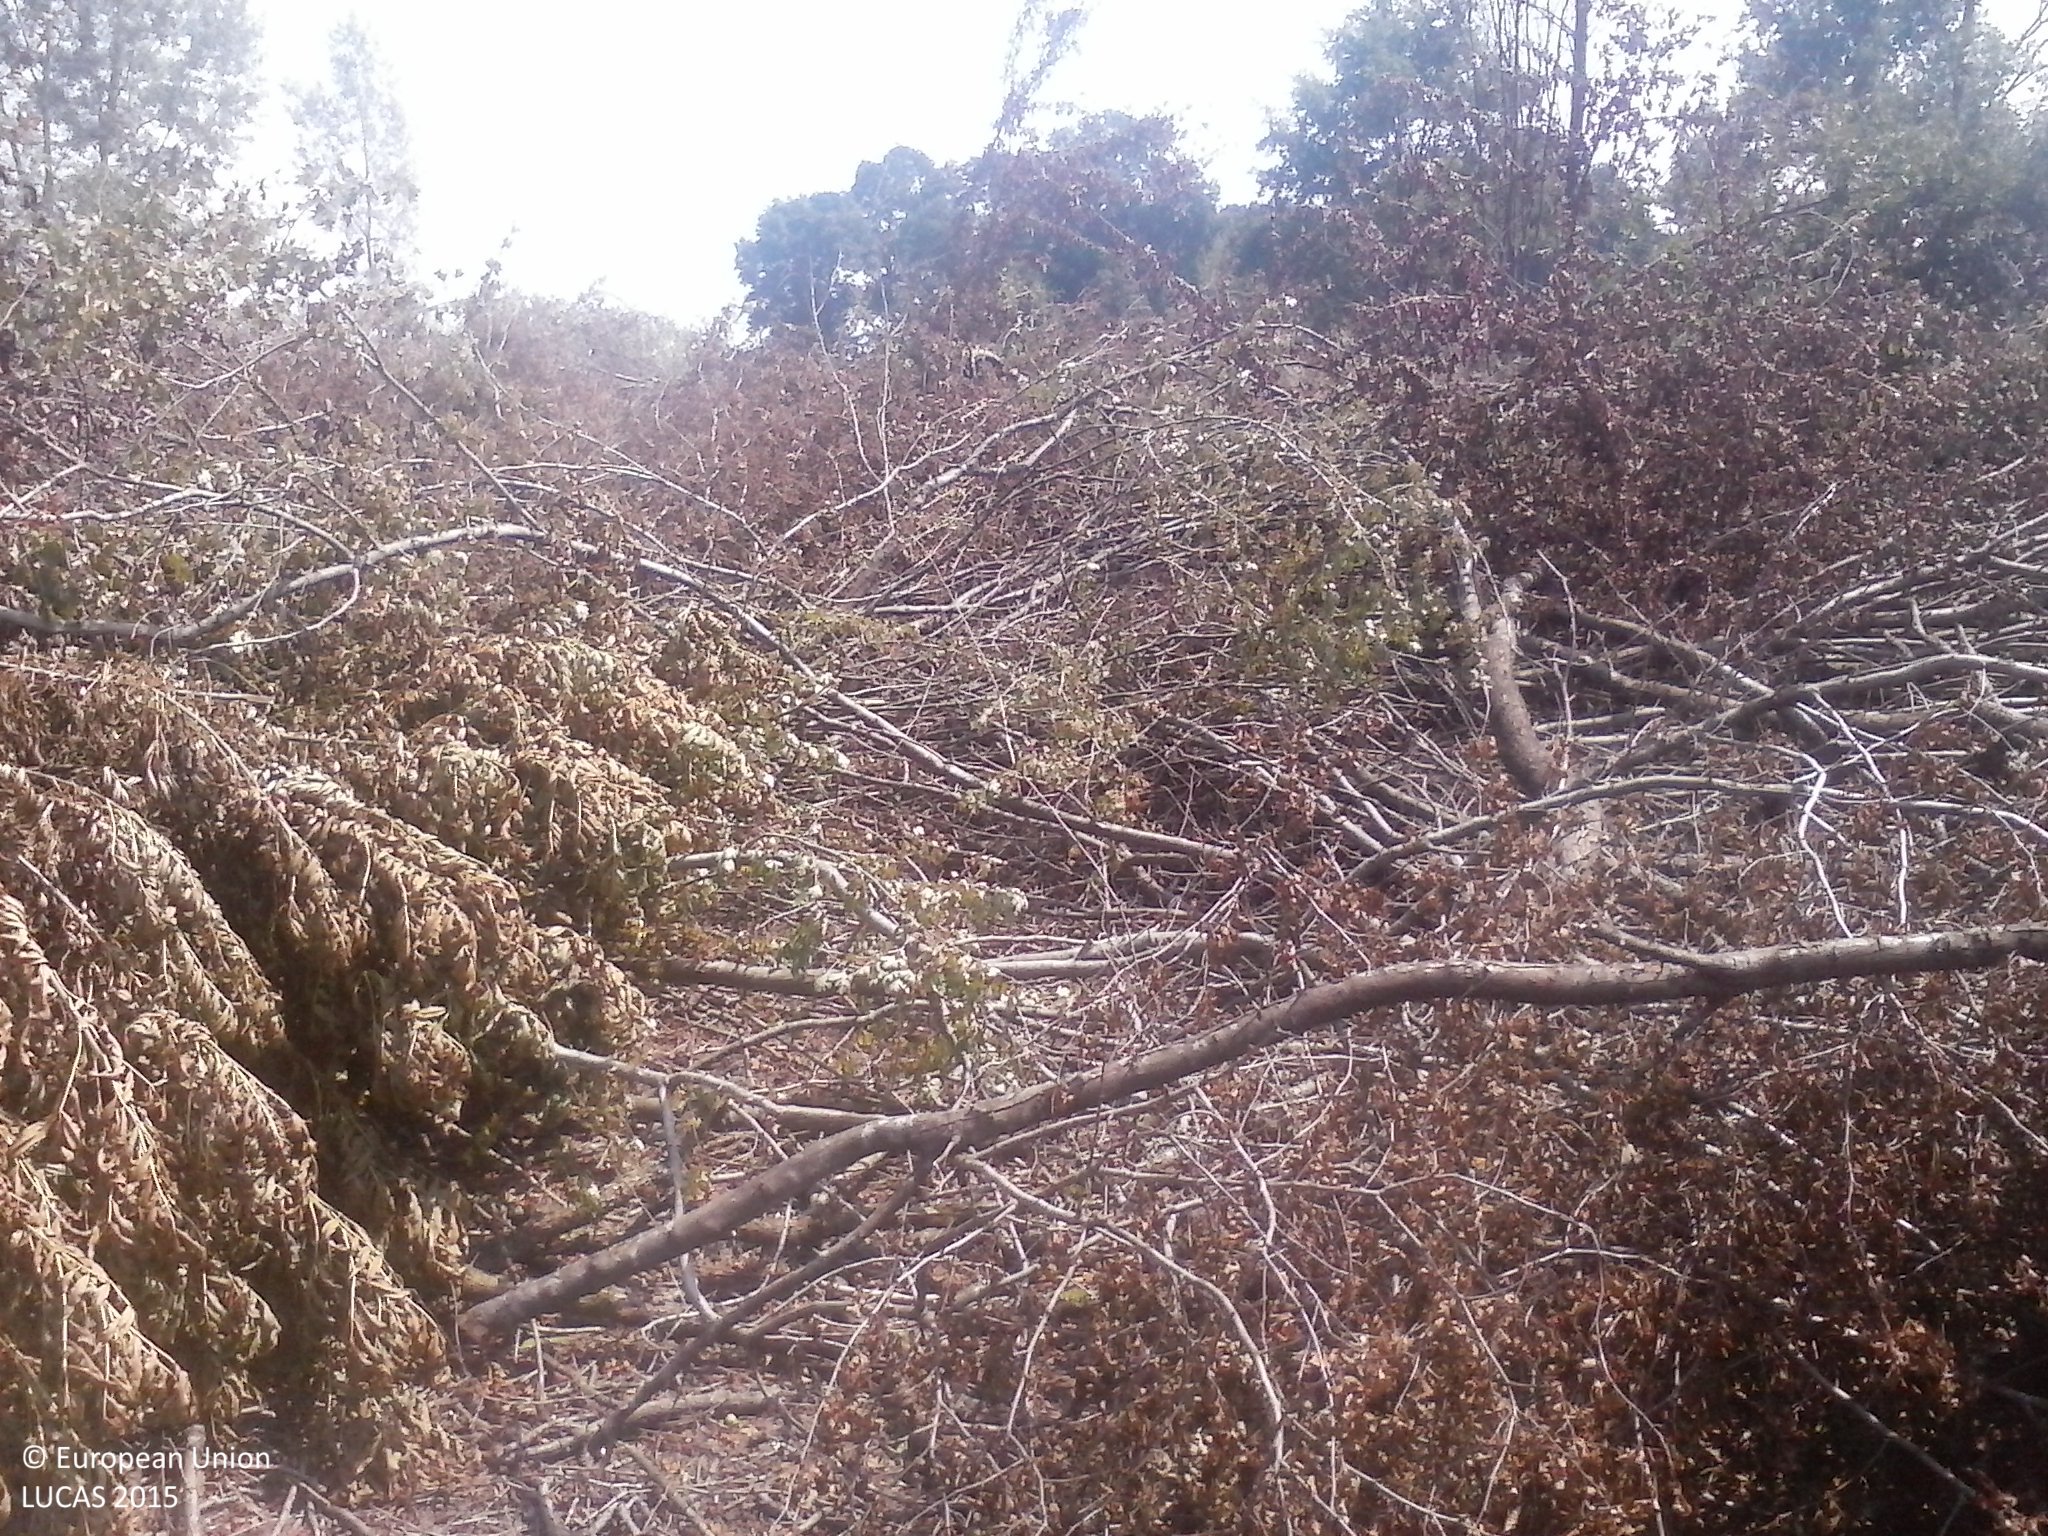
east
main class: Woodland
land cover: Broadleaved woodland
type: mesophytic deciduous forest
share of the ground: > 75 %
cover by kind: broadleaved forest trees 90 %, shrubs 5 %, herbaceous plants 5 %
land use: Forestry
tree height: < 5 m
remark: Clear cut
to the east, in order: Broadleaved woodland; Shrubland with sparse tree cover; Broadleaved woodland; Spontaneously vegetated surfaces; Abandoned hedges; Spontaneously vegetated surfaces
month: August
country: HU
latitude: 45.9210
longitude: 17.8053
